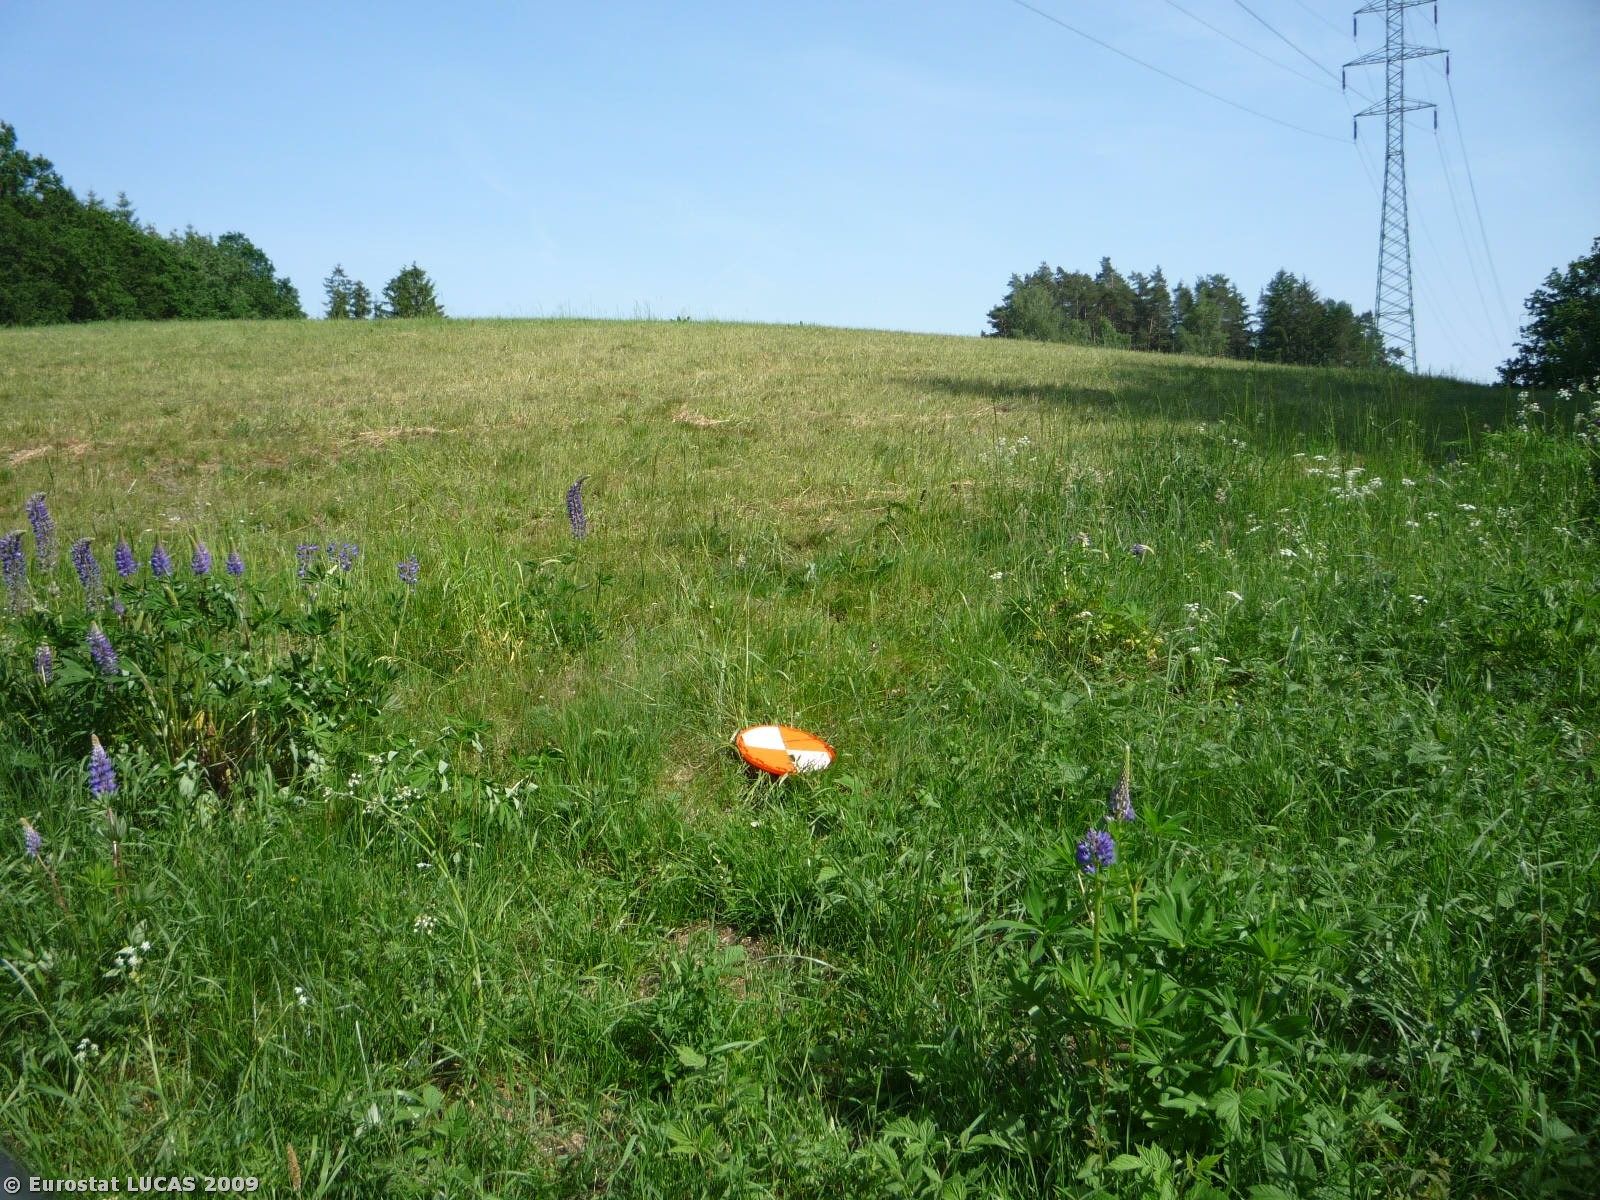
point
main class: Grassland
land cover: Spontaneously vegetated surfaces
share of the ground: > 75 %
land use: Fallow land
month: May
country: CZ
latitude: 49.7318
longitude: 15.0111
